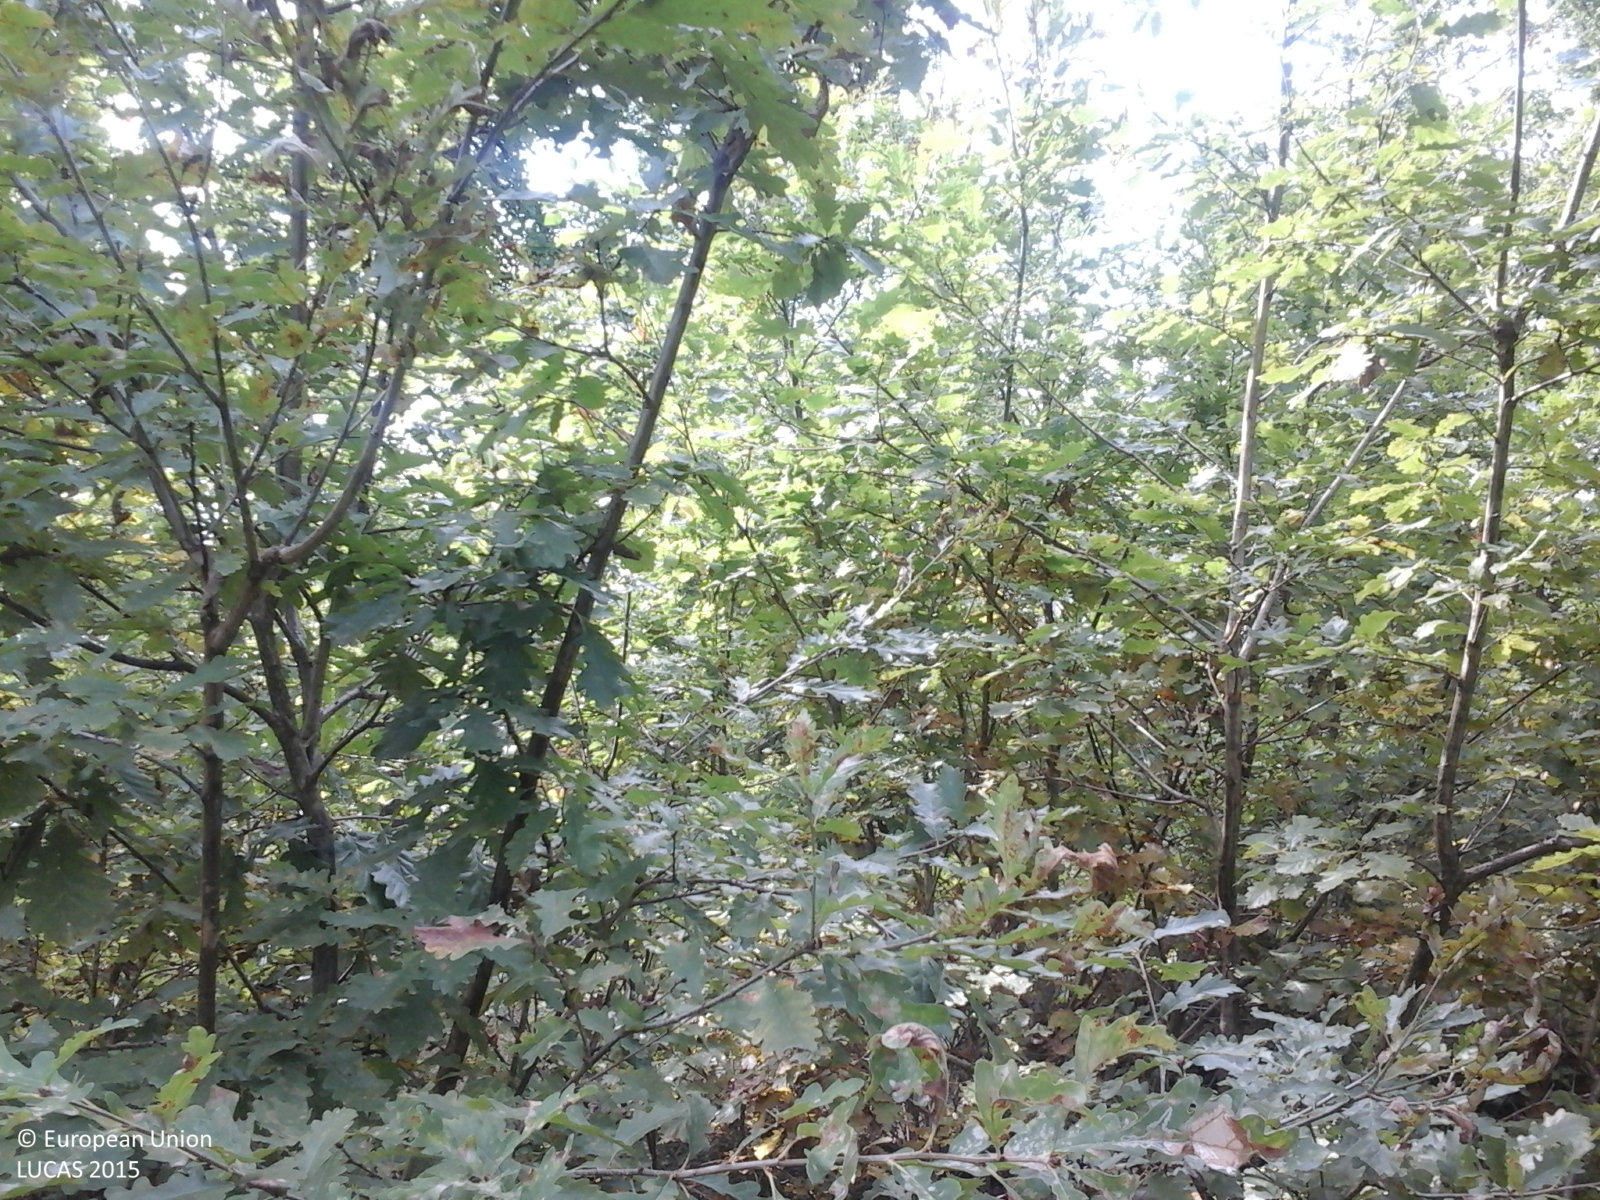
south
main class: Woodland
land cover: Broadleaved woodland
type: acidophilous oak and oak-birch forest
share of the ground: > 75 %
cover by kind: broadleaved forest trees 100 %
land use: Forestry
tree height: > 5 m
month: September
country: RO
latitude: 46.6566
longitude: 23.5157
